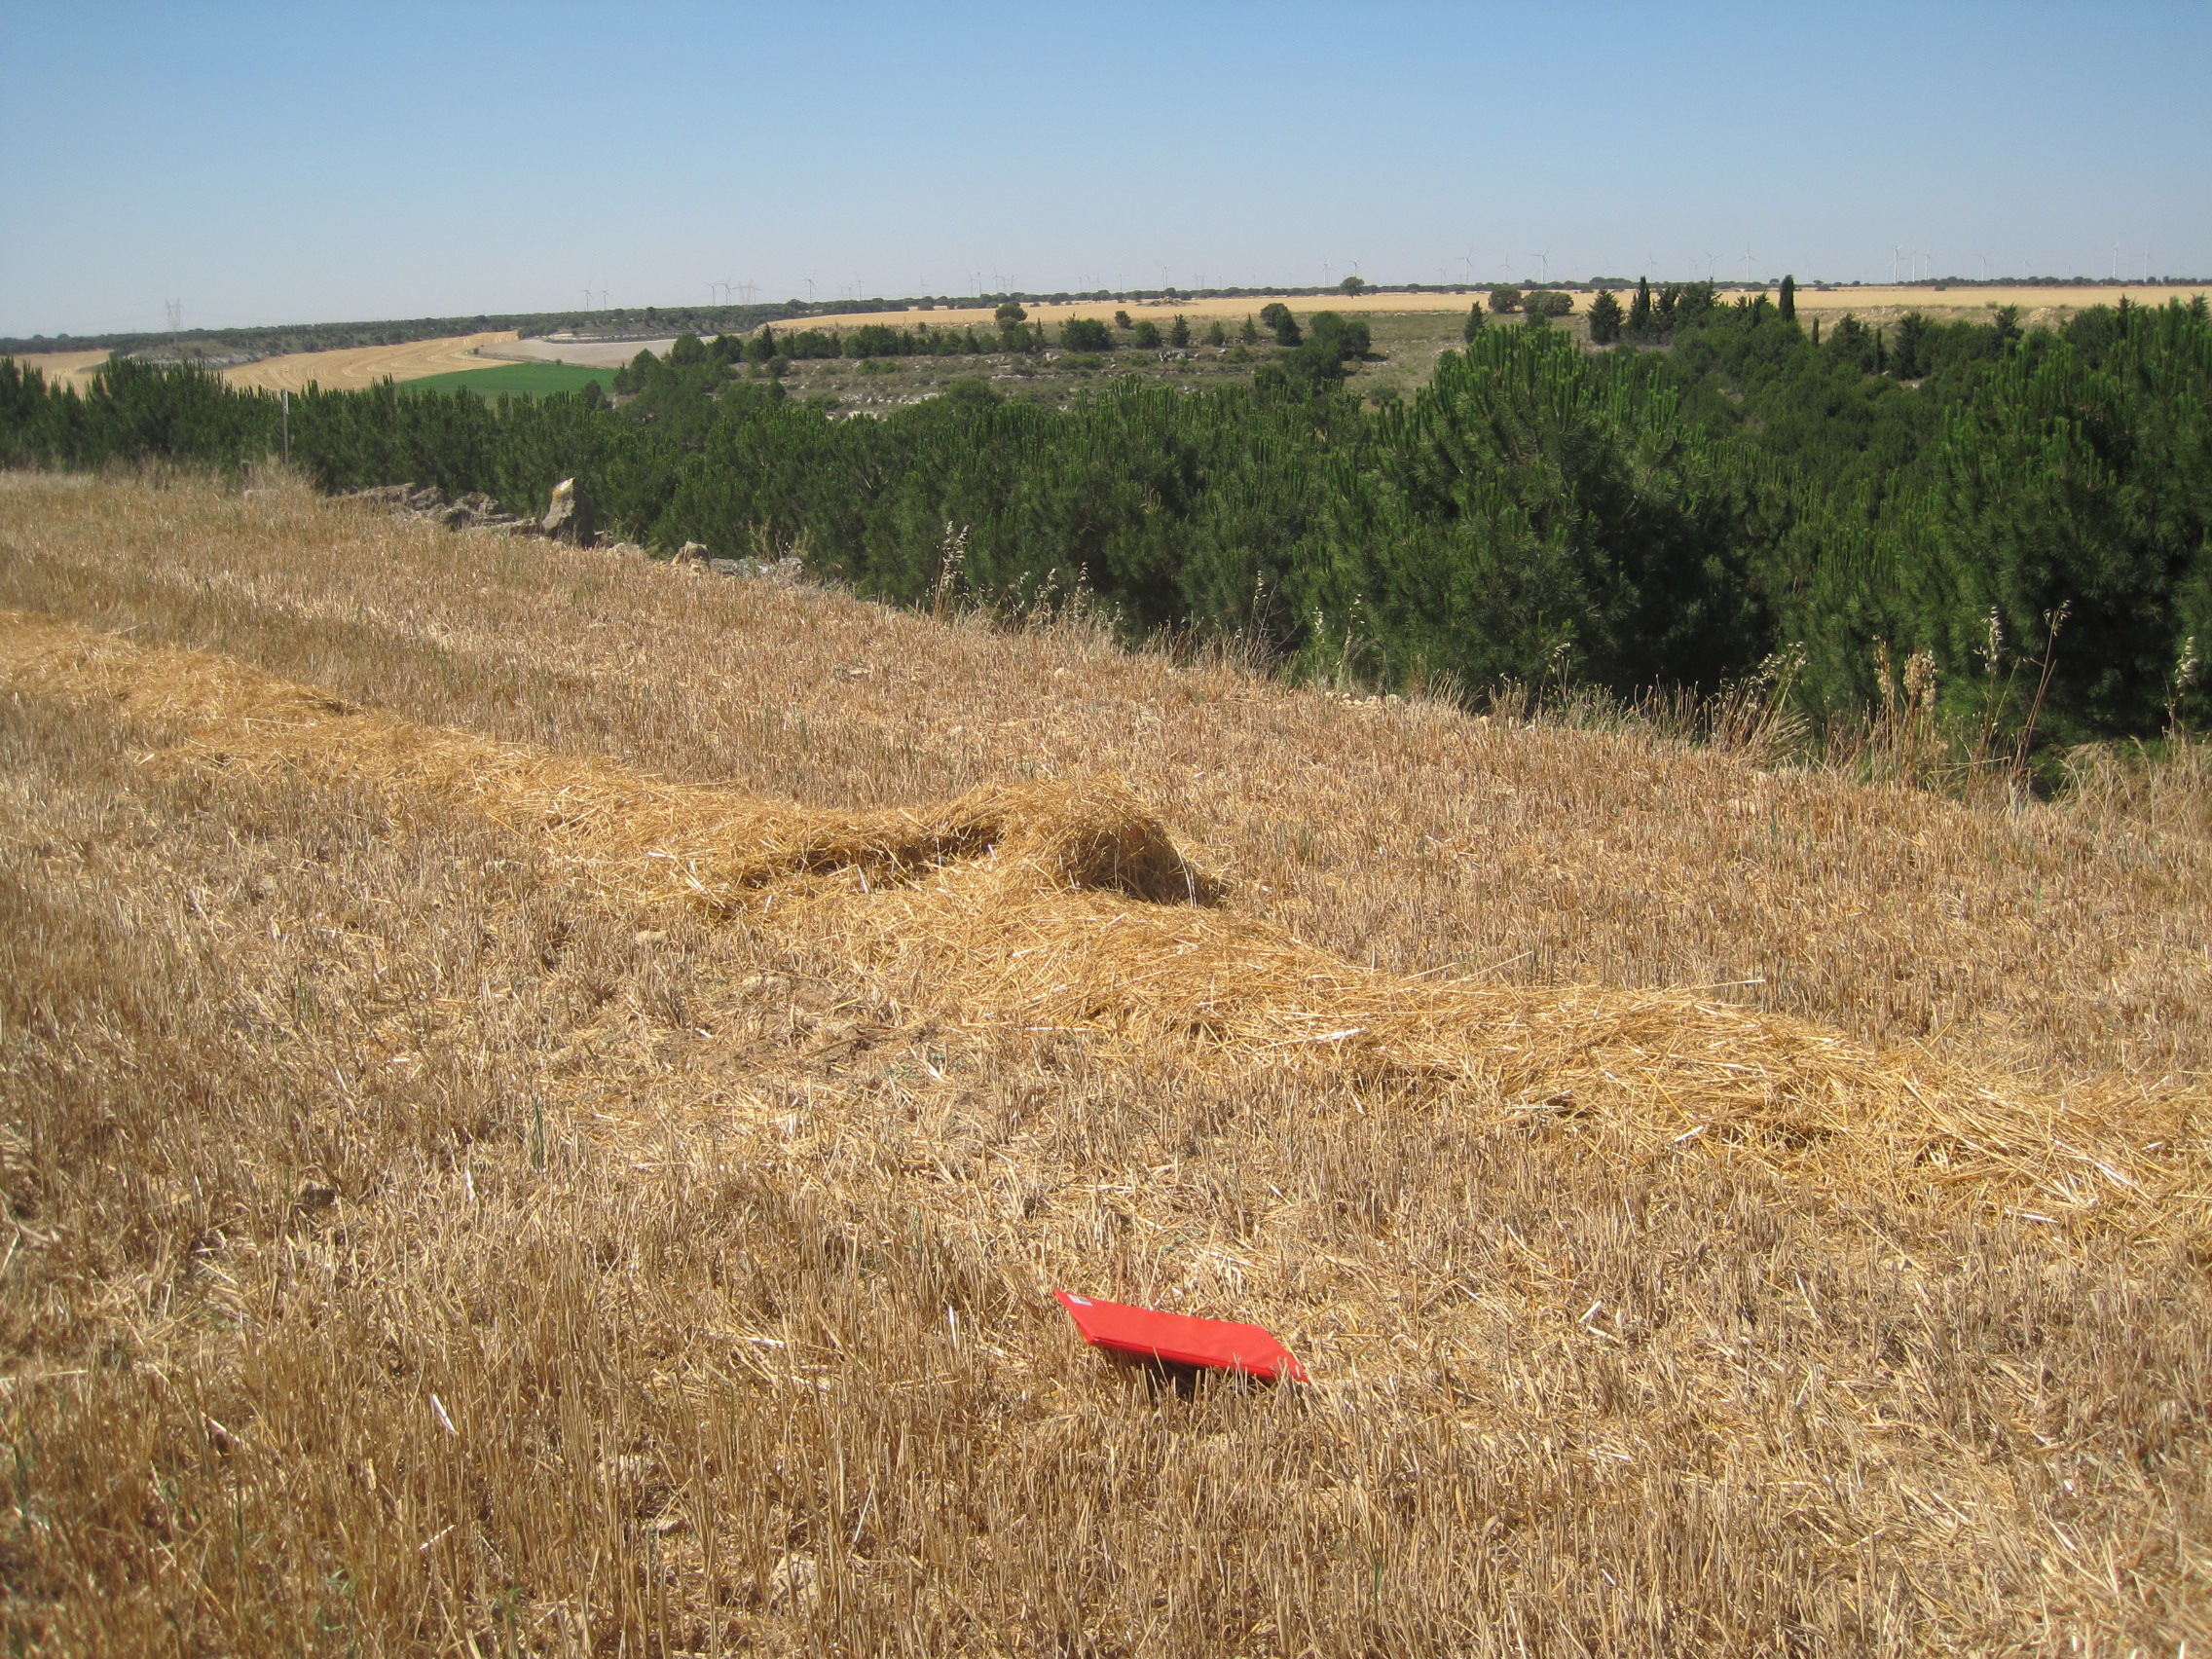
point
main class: Cropland
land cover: Oats
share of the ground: < 10 %
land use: Agriculture (excluding fallow land and kitchen gardens)
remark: Harvested field
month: July
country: ES
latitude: 41.9232
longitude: -4.6988
